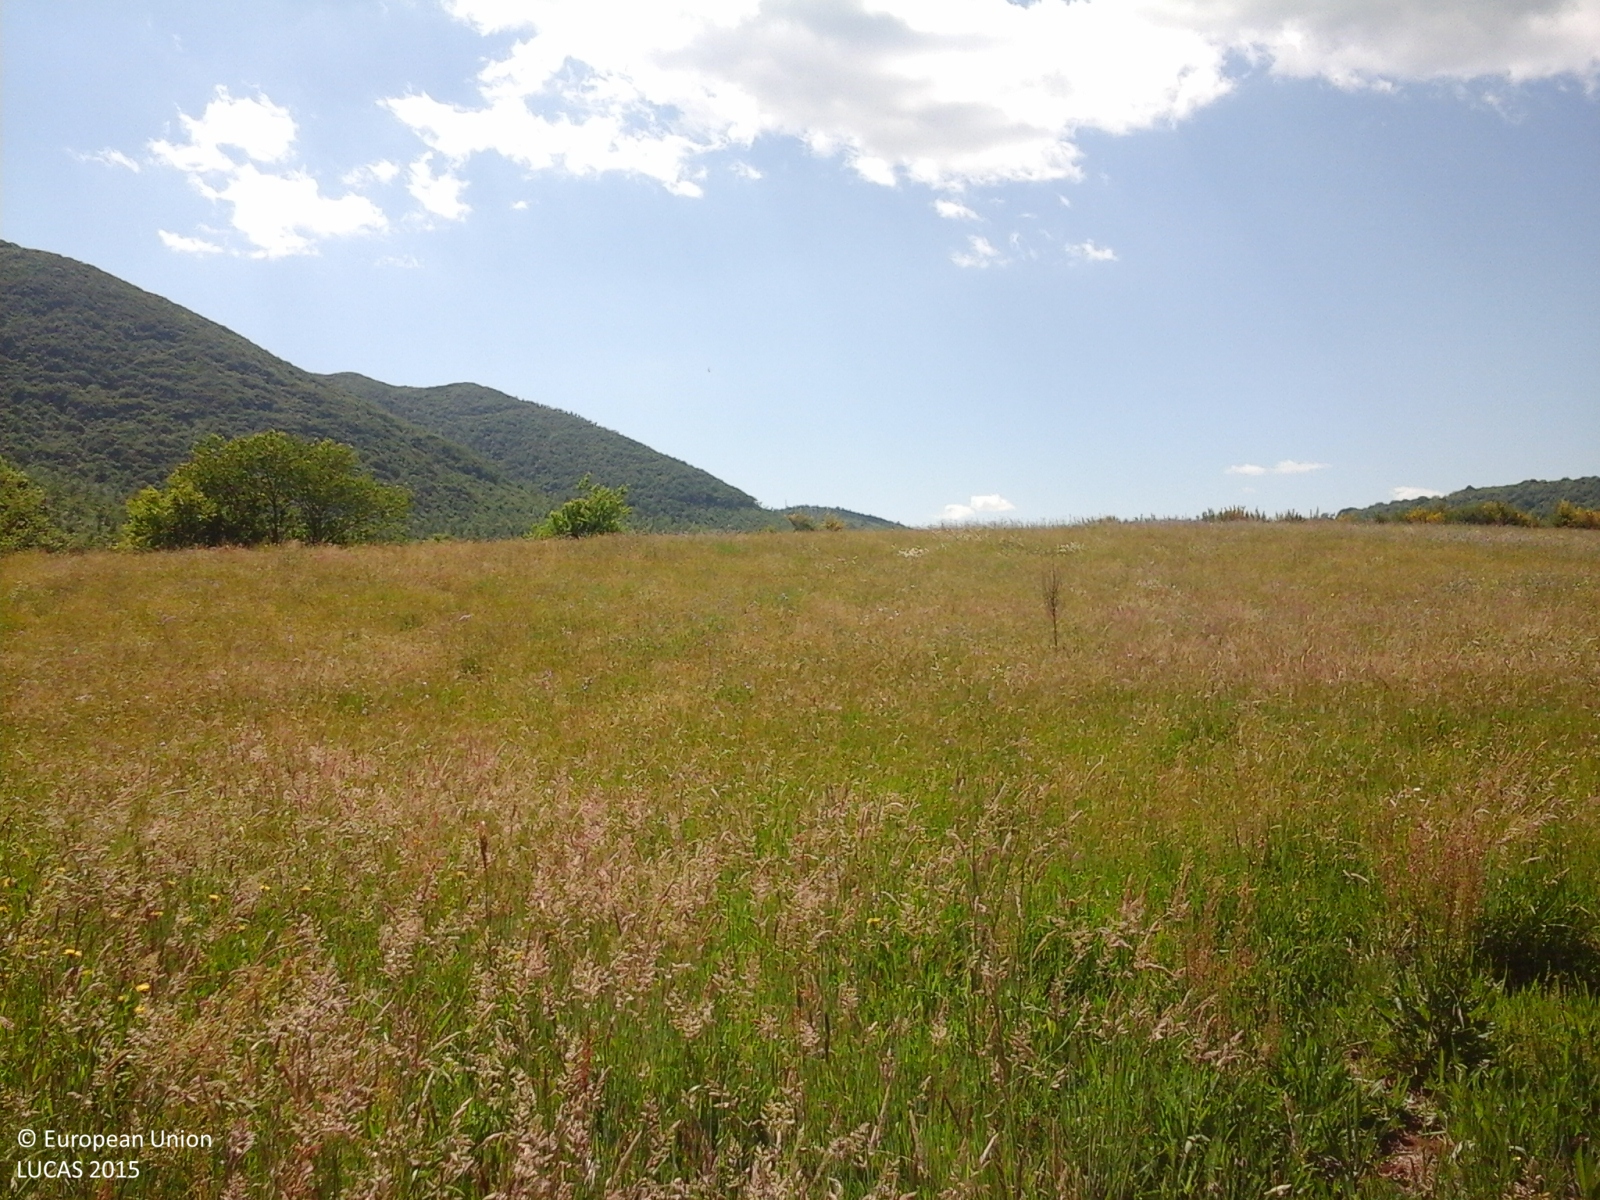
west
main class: Grassland
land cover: Grassland without tree/shrub cover
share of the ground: > 75 %
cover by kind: herbaceous plants 100 %
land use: Agriculture (excluding fallow land and kitchen gardens)
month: May
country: IT
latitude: 41.7710
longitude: 13.2241
